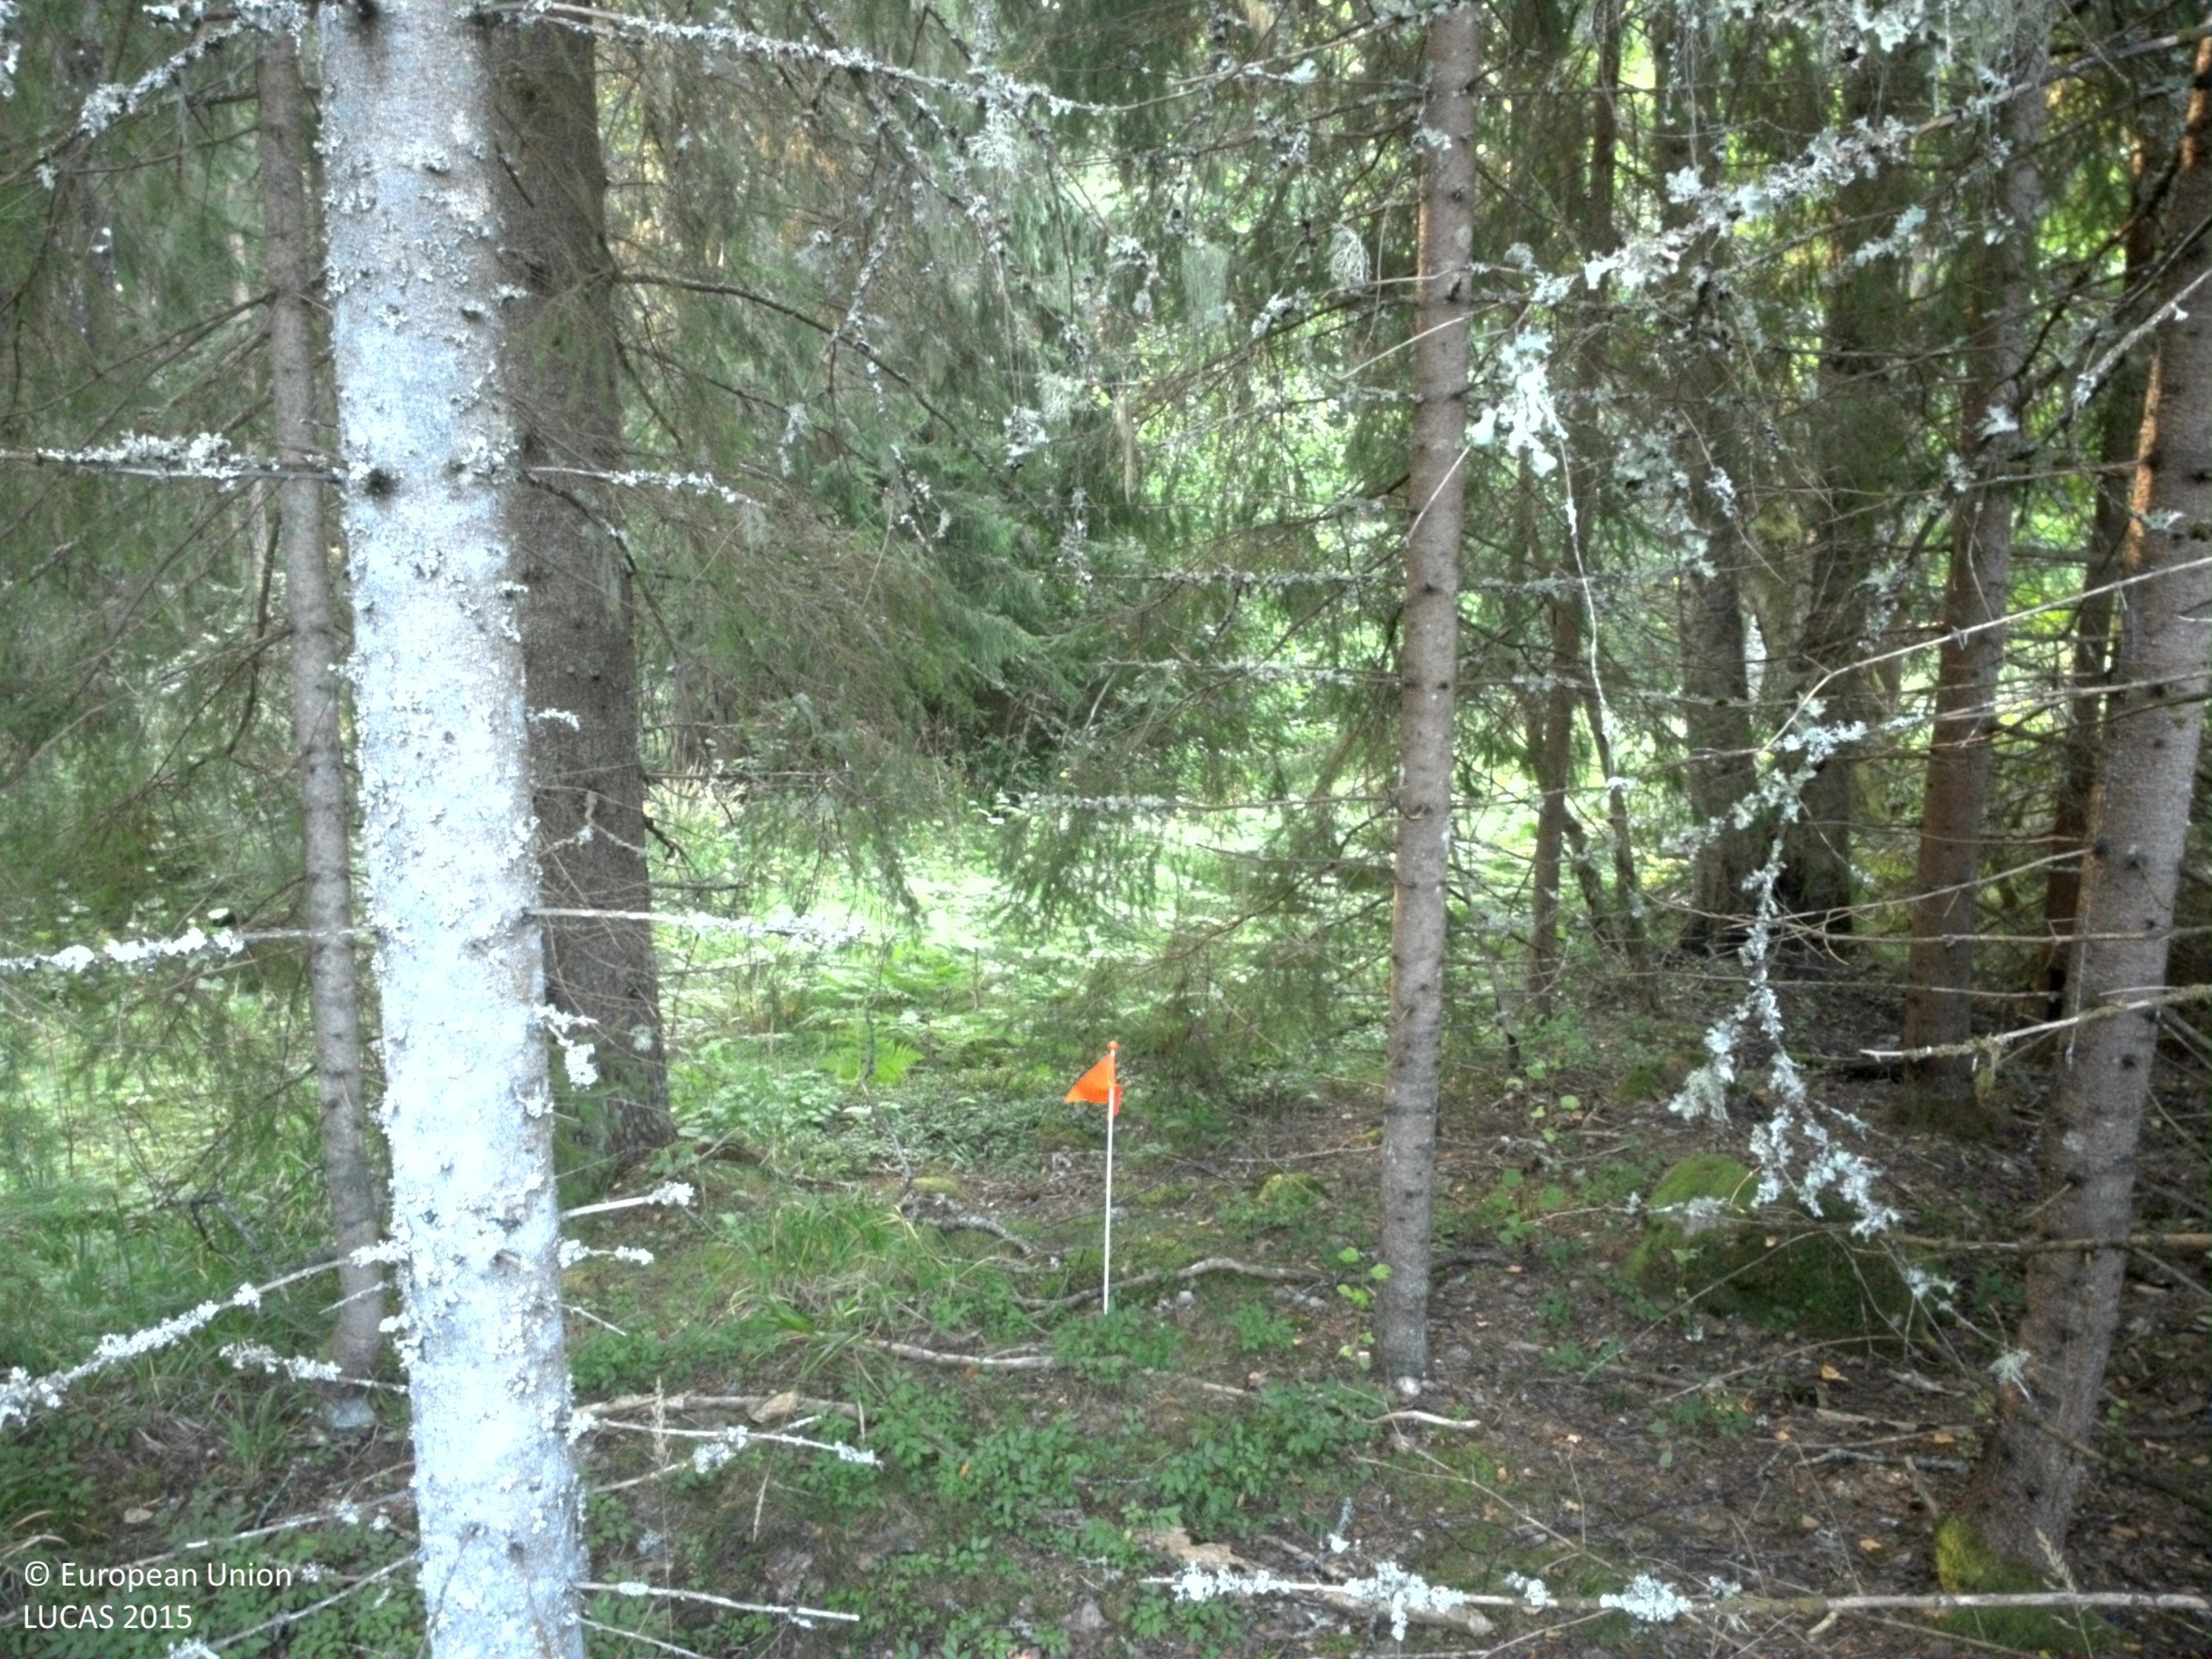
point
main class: Woodland
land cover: Spruce dominated mixed woodland
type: boreal forest
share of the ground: 50 - 75 %
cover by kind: coniferous forest trees 40 %, broadleaved forest trees 30 %, shrubs 15 %, herbaceous plants 15 %
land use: Forestry
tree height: > 5 m
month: August
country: SE
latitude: 59.8437
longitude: 15.8259
